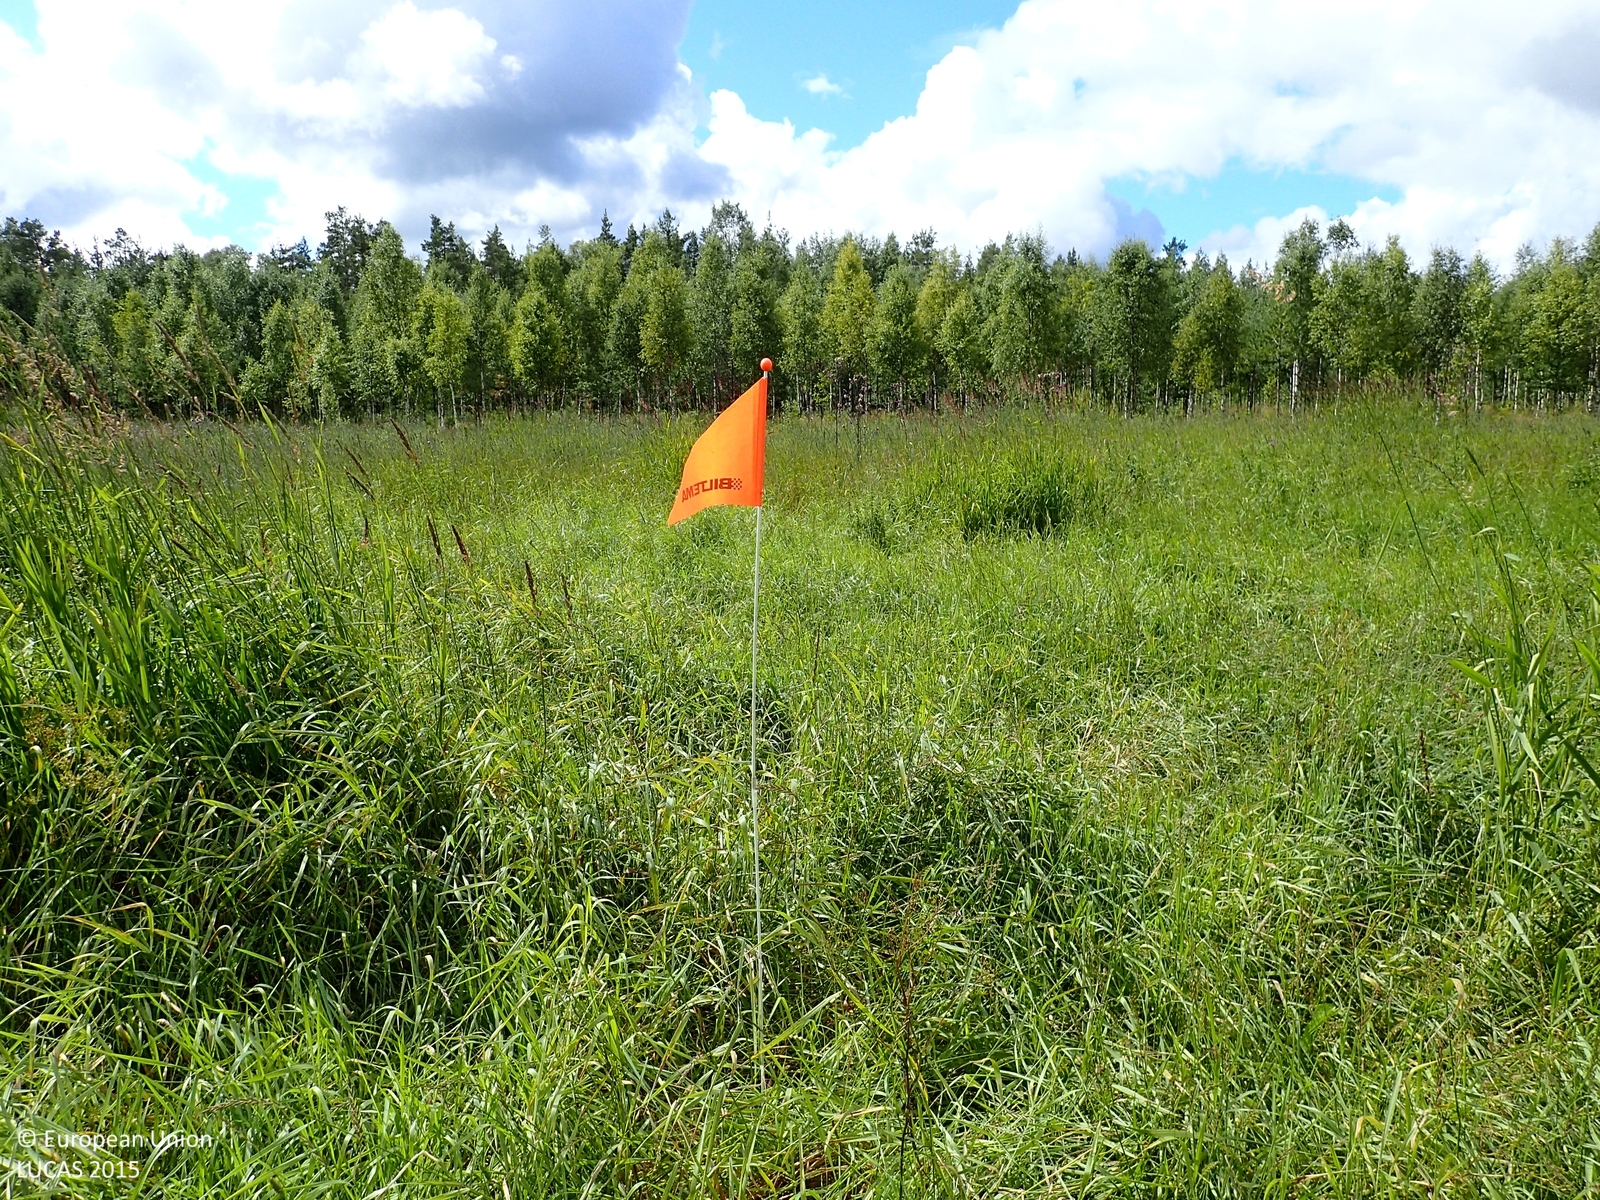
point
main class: Grassland
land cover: Spontaneously vegetated surfaces
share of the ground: > 75 %
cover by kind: herbaceous plants 100 %
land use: Fallow land
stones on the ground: < 10 %
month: August
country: FI
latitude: 62.6484
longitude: 21.6915
